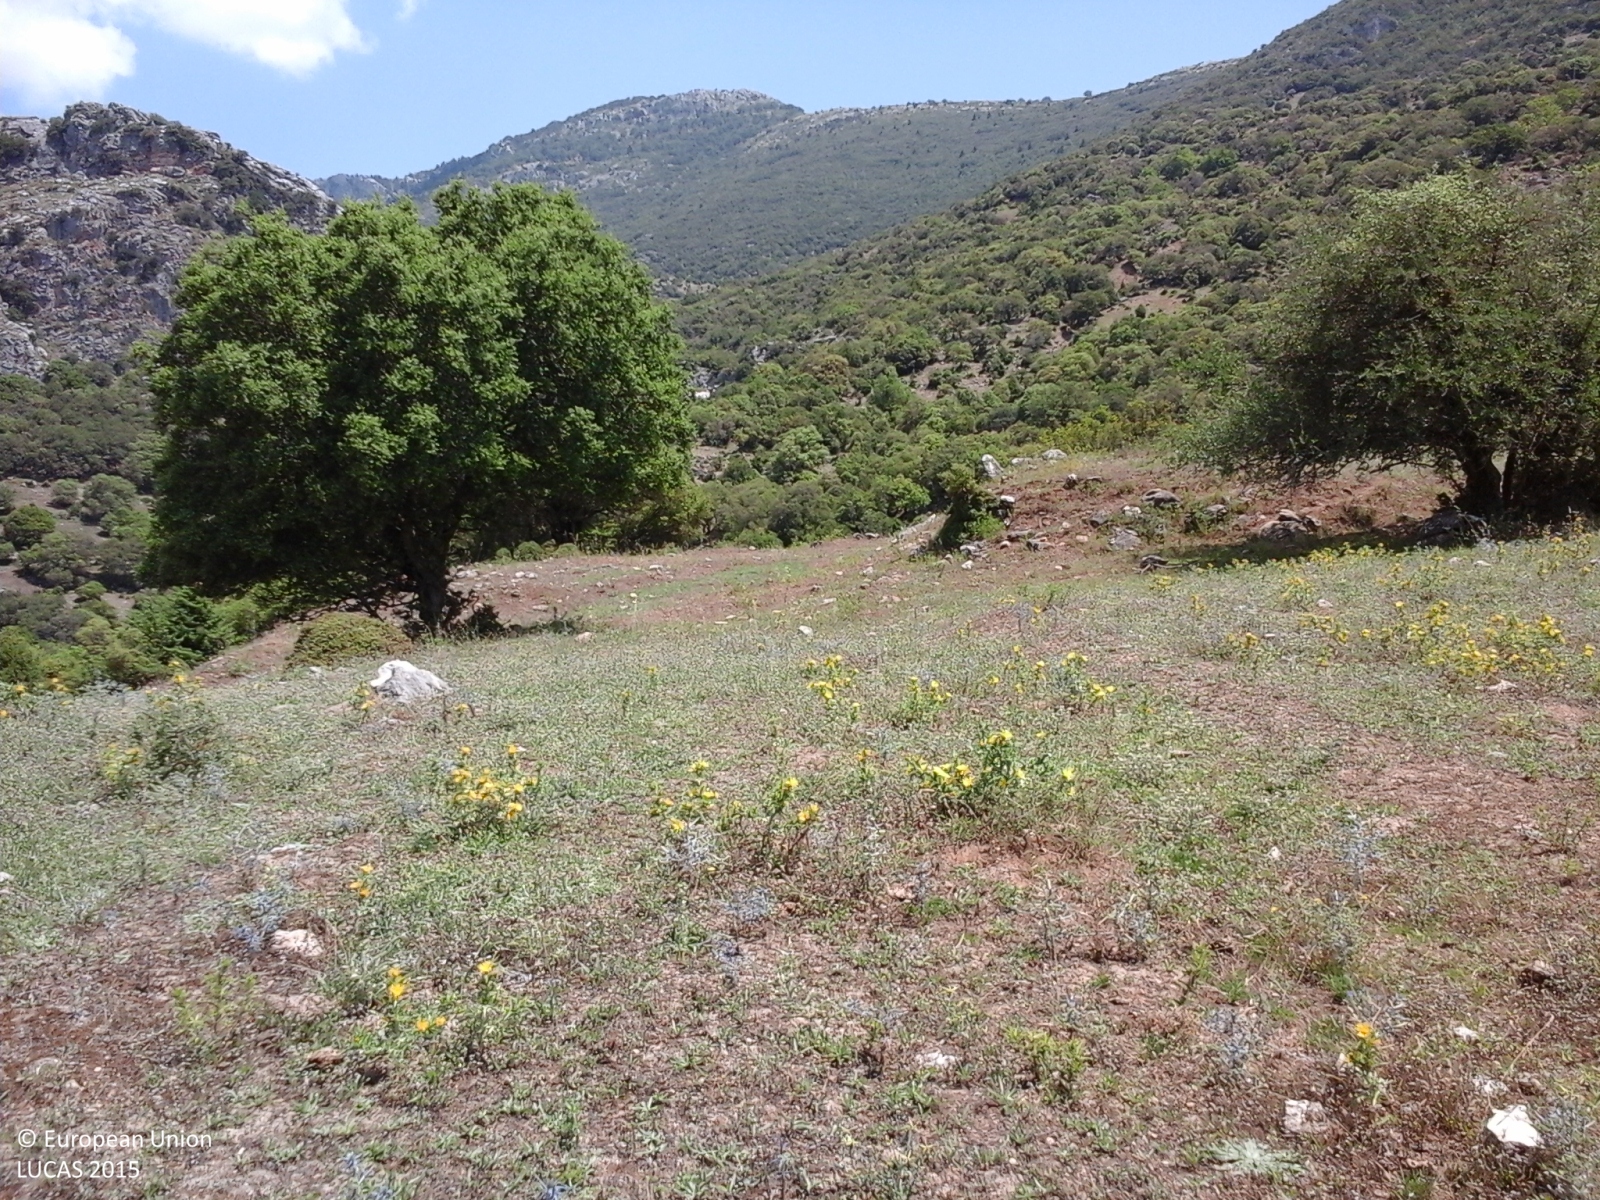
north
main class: Grassland
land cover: Grassland with sparse tree/shrub cover
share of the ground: > 75 %
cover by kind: herbaceous plants 75 %, unconsolidated bare surface 15 %, broadleaved forest trees 5 %, shrubs 5 %
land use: Agriculture (excluding fallow land and kitchen gardens)
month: July
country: GR
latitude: 38.5583
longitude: 22.1498
